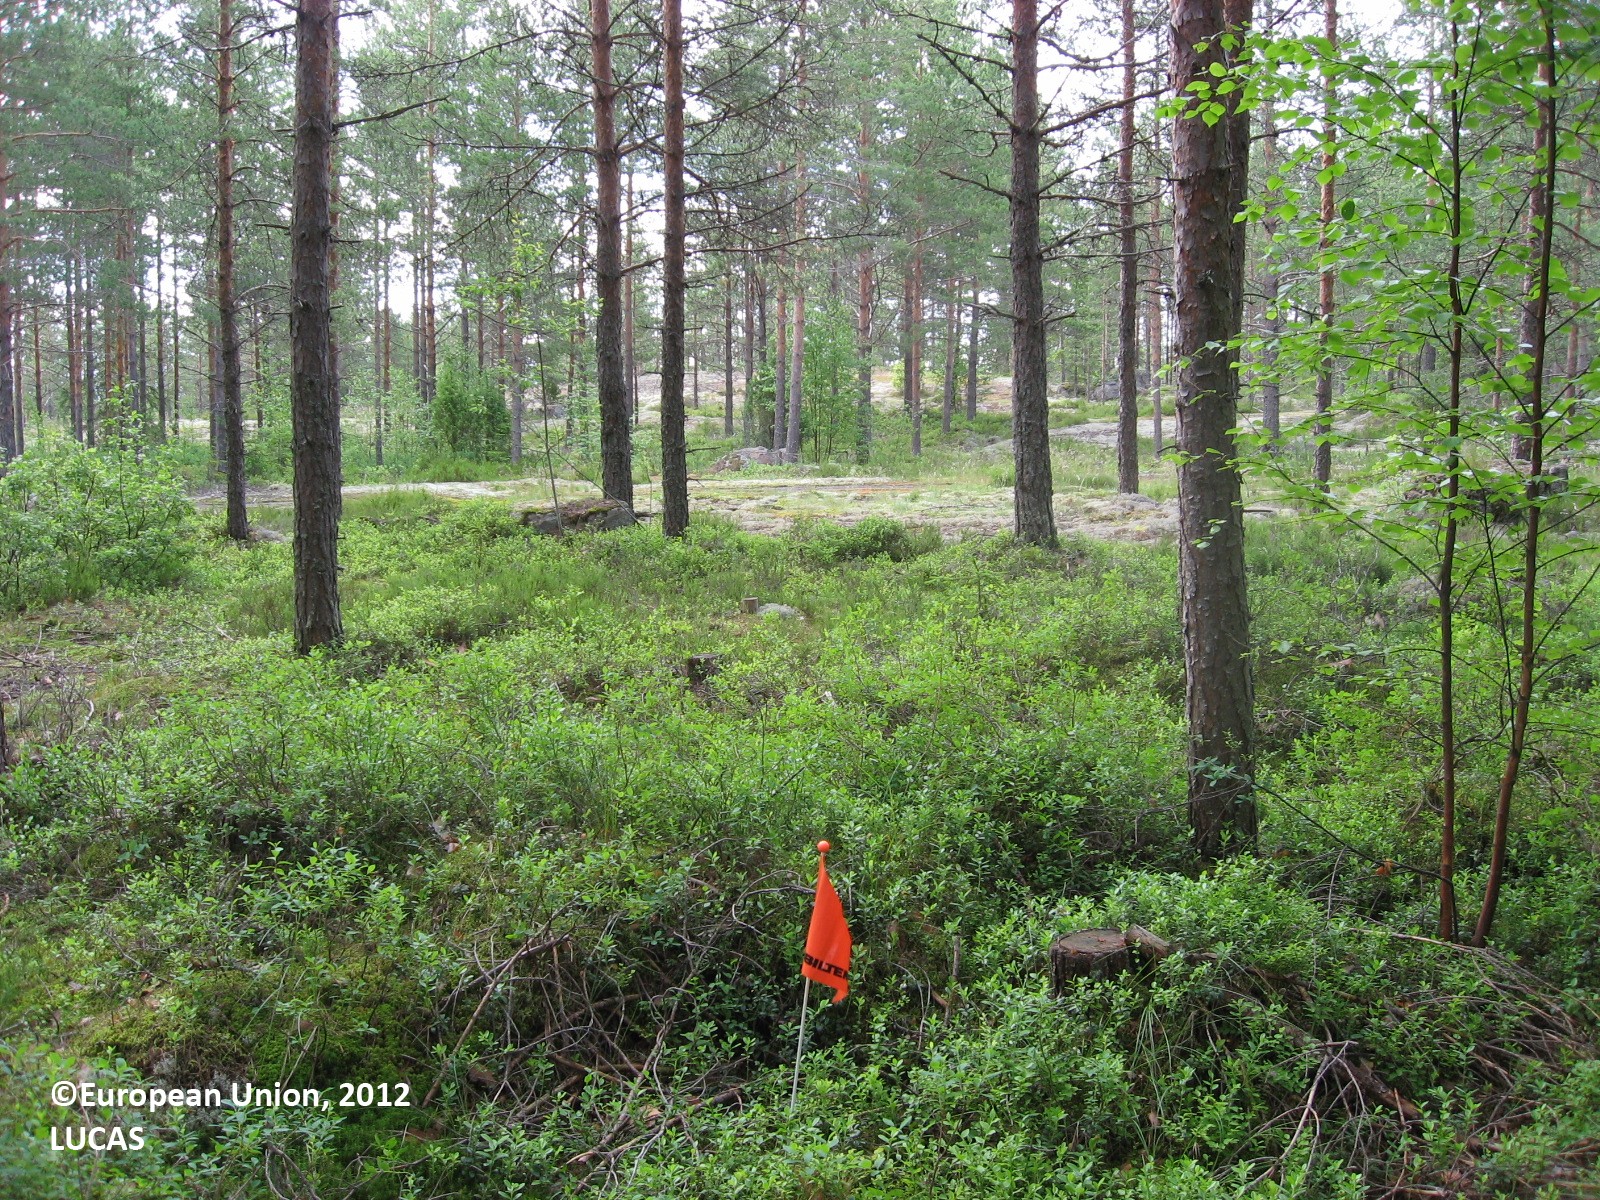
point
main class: Woodland
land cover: Pine dominated coniferous woodland
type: boreal forest
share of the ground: 50 - 75 %
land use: Forestry
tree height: > 5 m
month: June
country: FI
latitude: 60.6559
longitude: 26.1894
